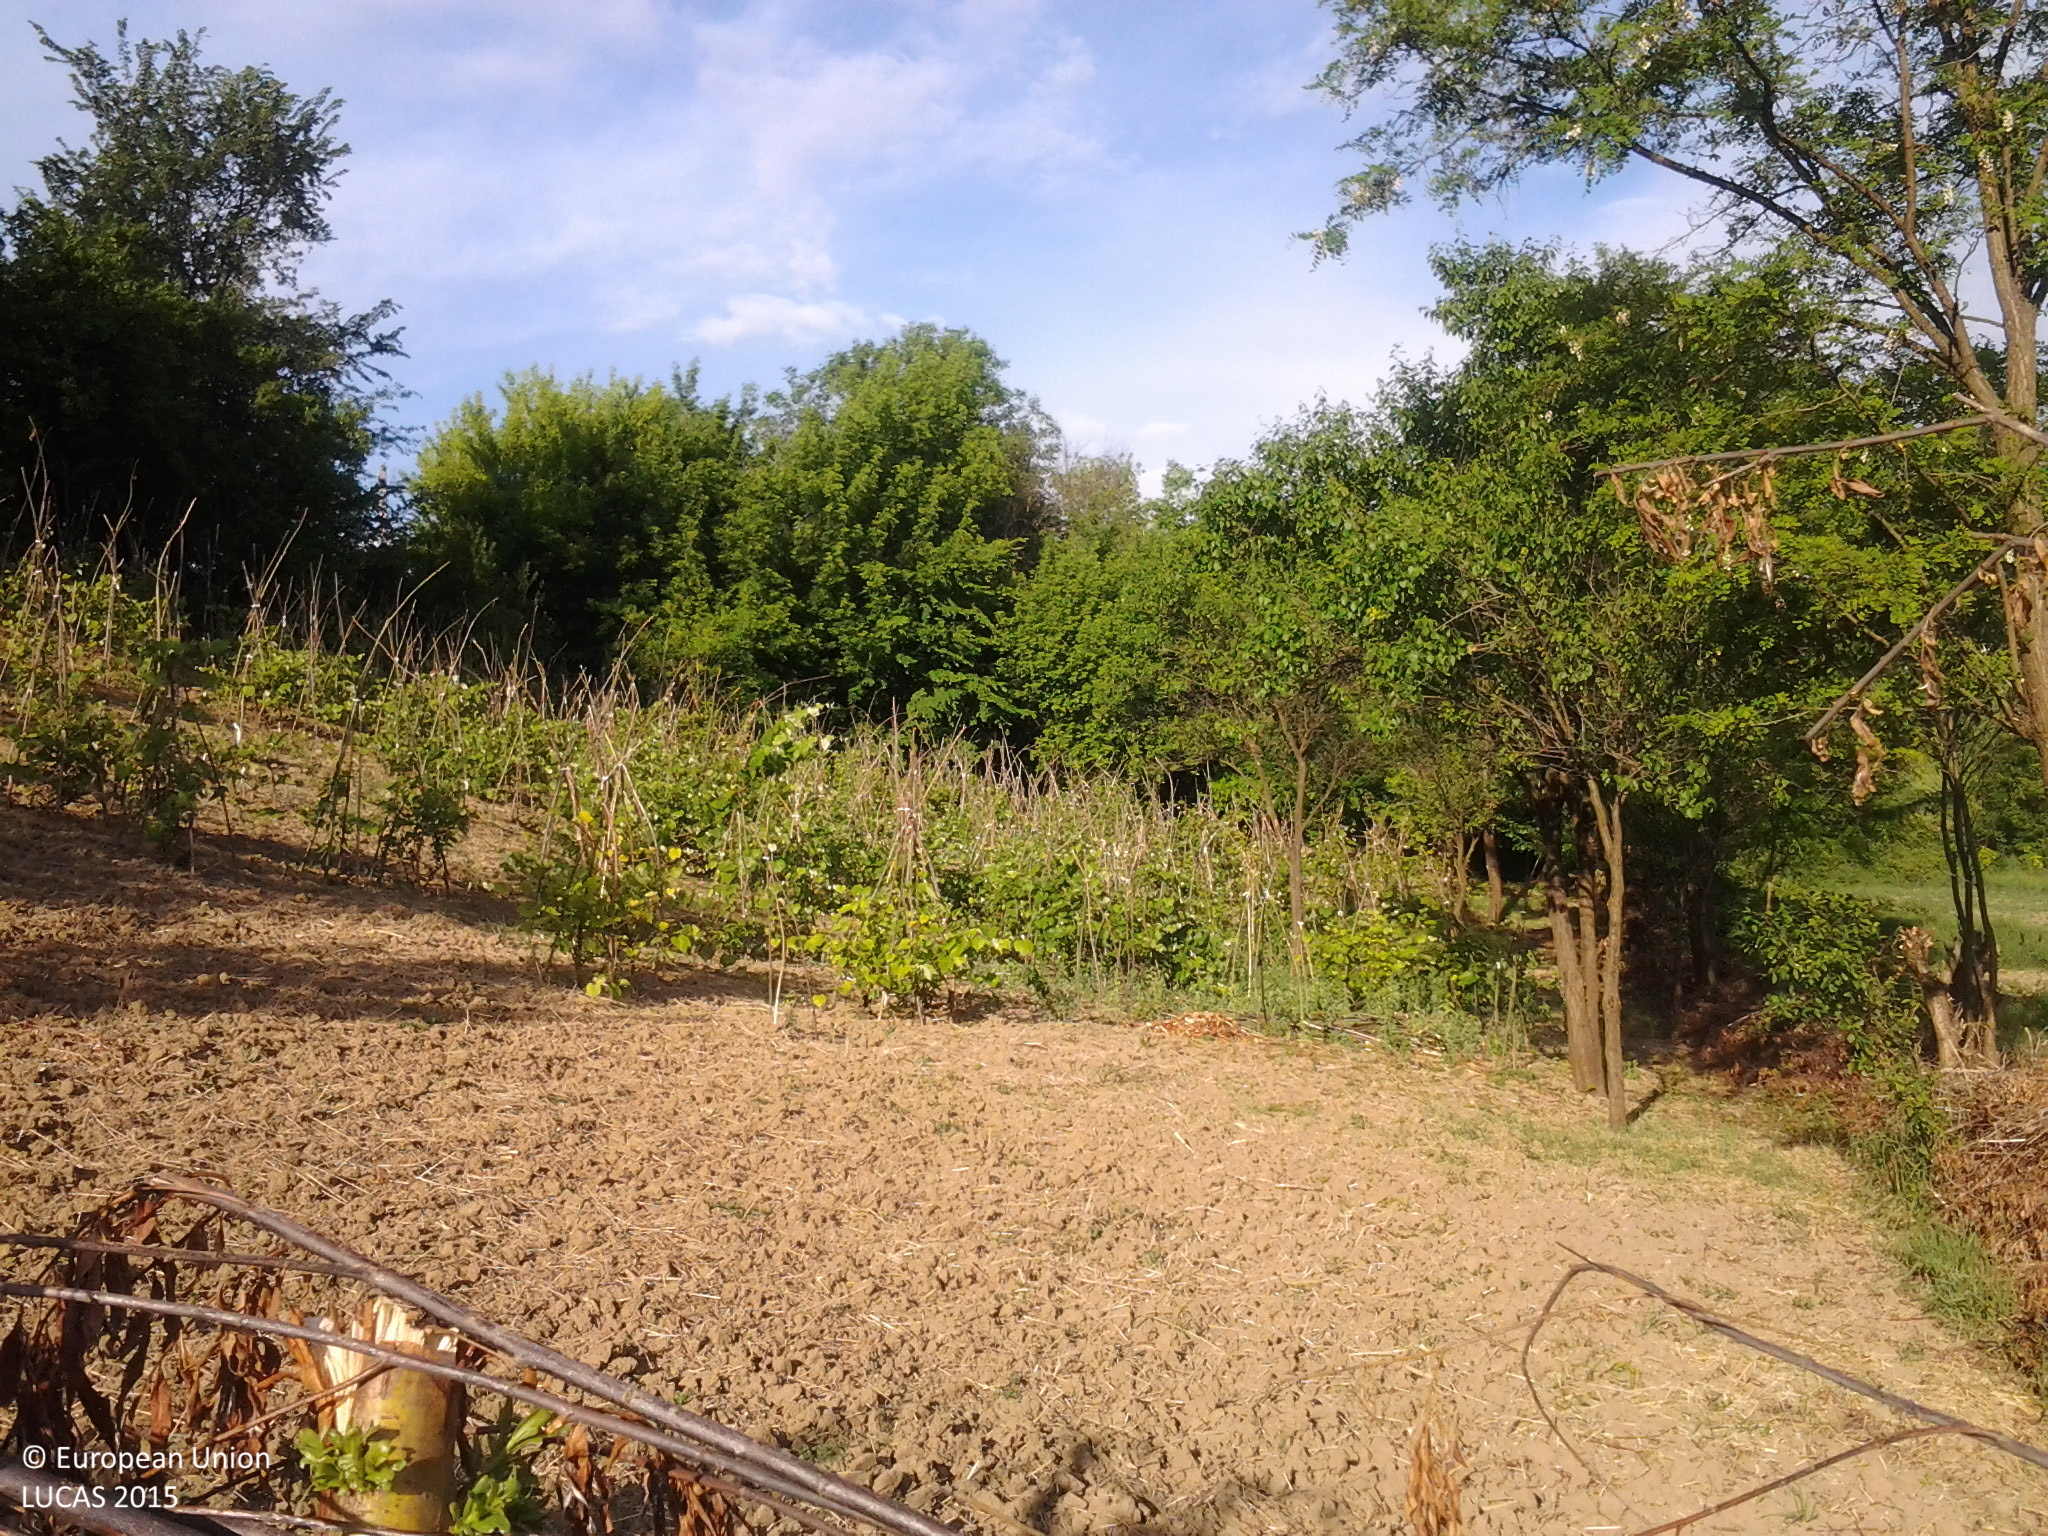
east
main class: Cropland
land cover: Vineyards
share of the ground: > 75 %
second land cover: Grassland without tree/shrub cover
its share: < 10 %
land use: Agriculture (excluding fallow land and kitchen gardens)
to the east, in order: Vineyards; Grassland without tree/shrub cover; Broadleaved woodland; Artificial constructions in urban areas; Grassland without tree/shrub cover; Paved roads, cycling and walking lanes; Grass margins; Ditches and canals; Lines of trees; Grassland without tree/shrub cover; Artificial constructions in urban areas; Arable land (only in case pi); Single bushes/trees; Abandoned hedges; Arable land (only in case pi)
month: June
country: RO
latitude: 46.3621
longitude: 26.7372
